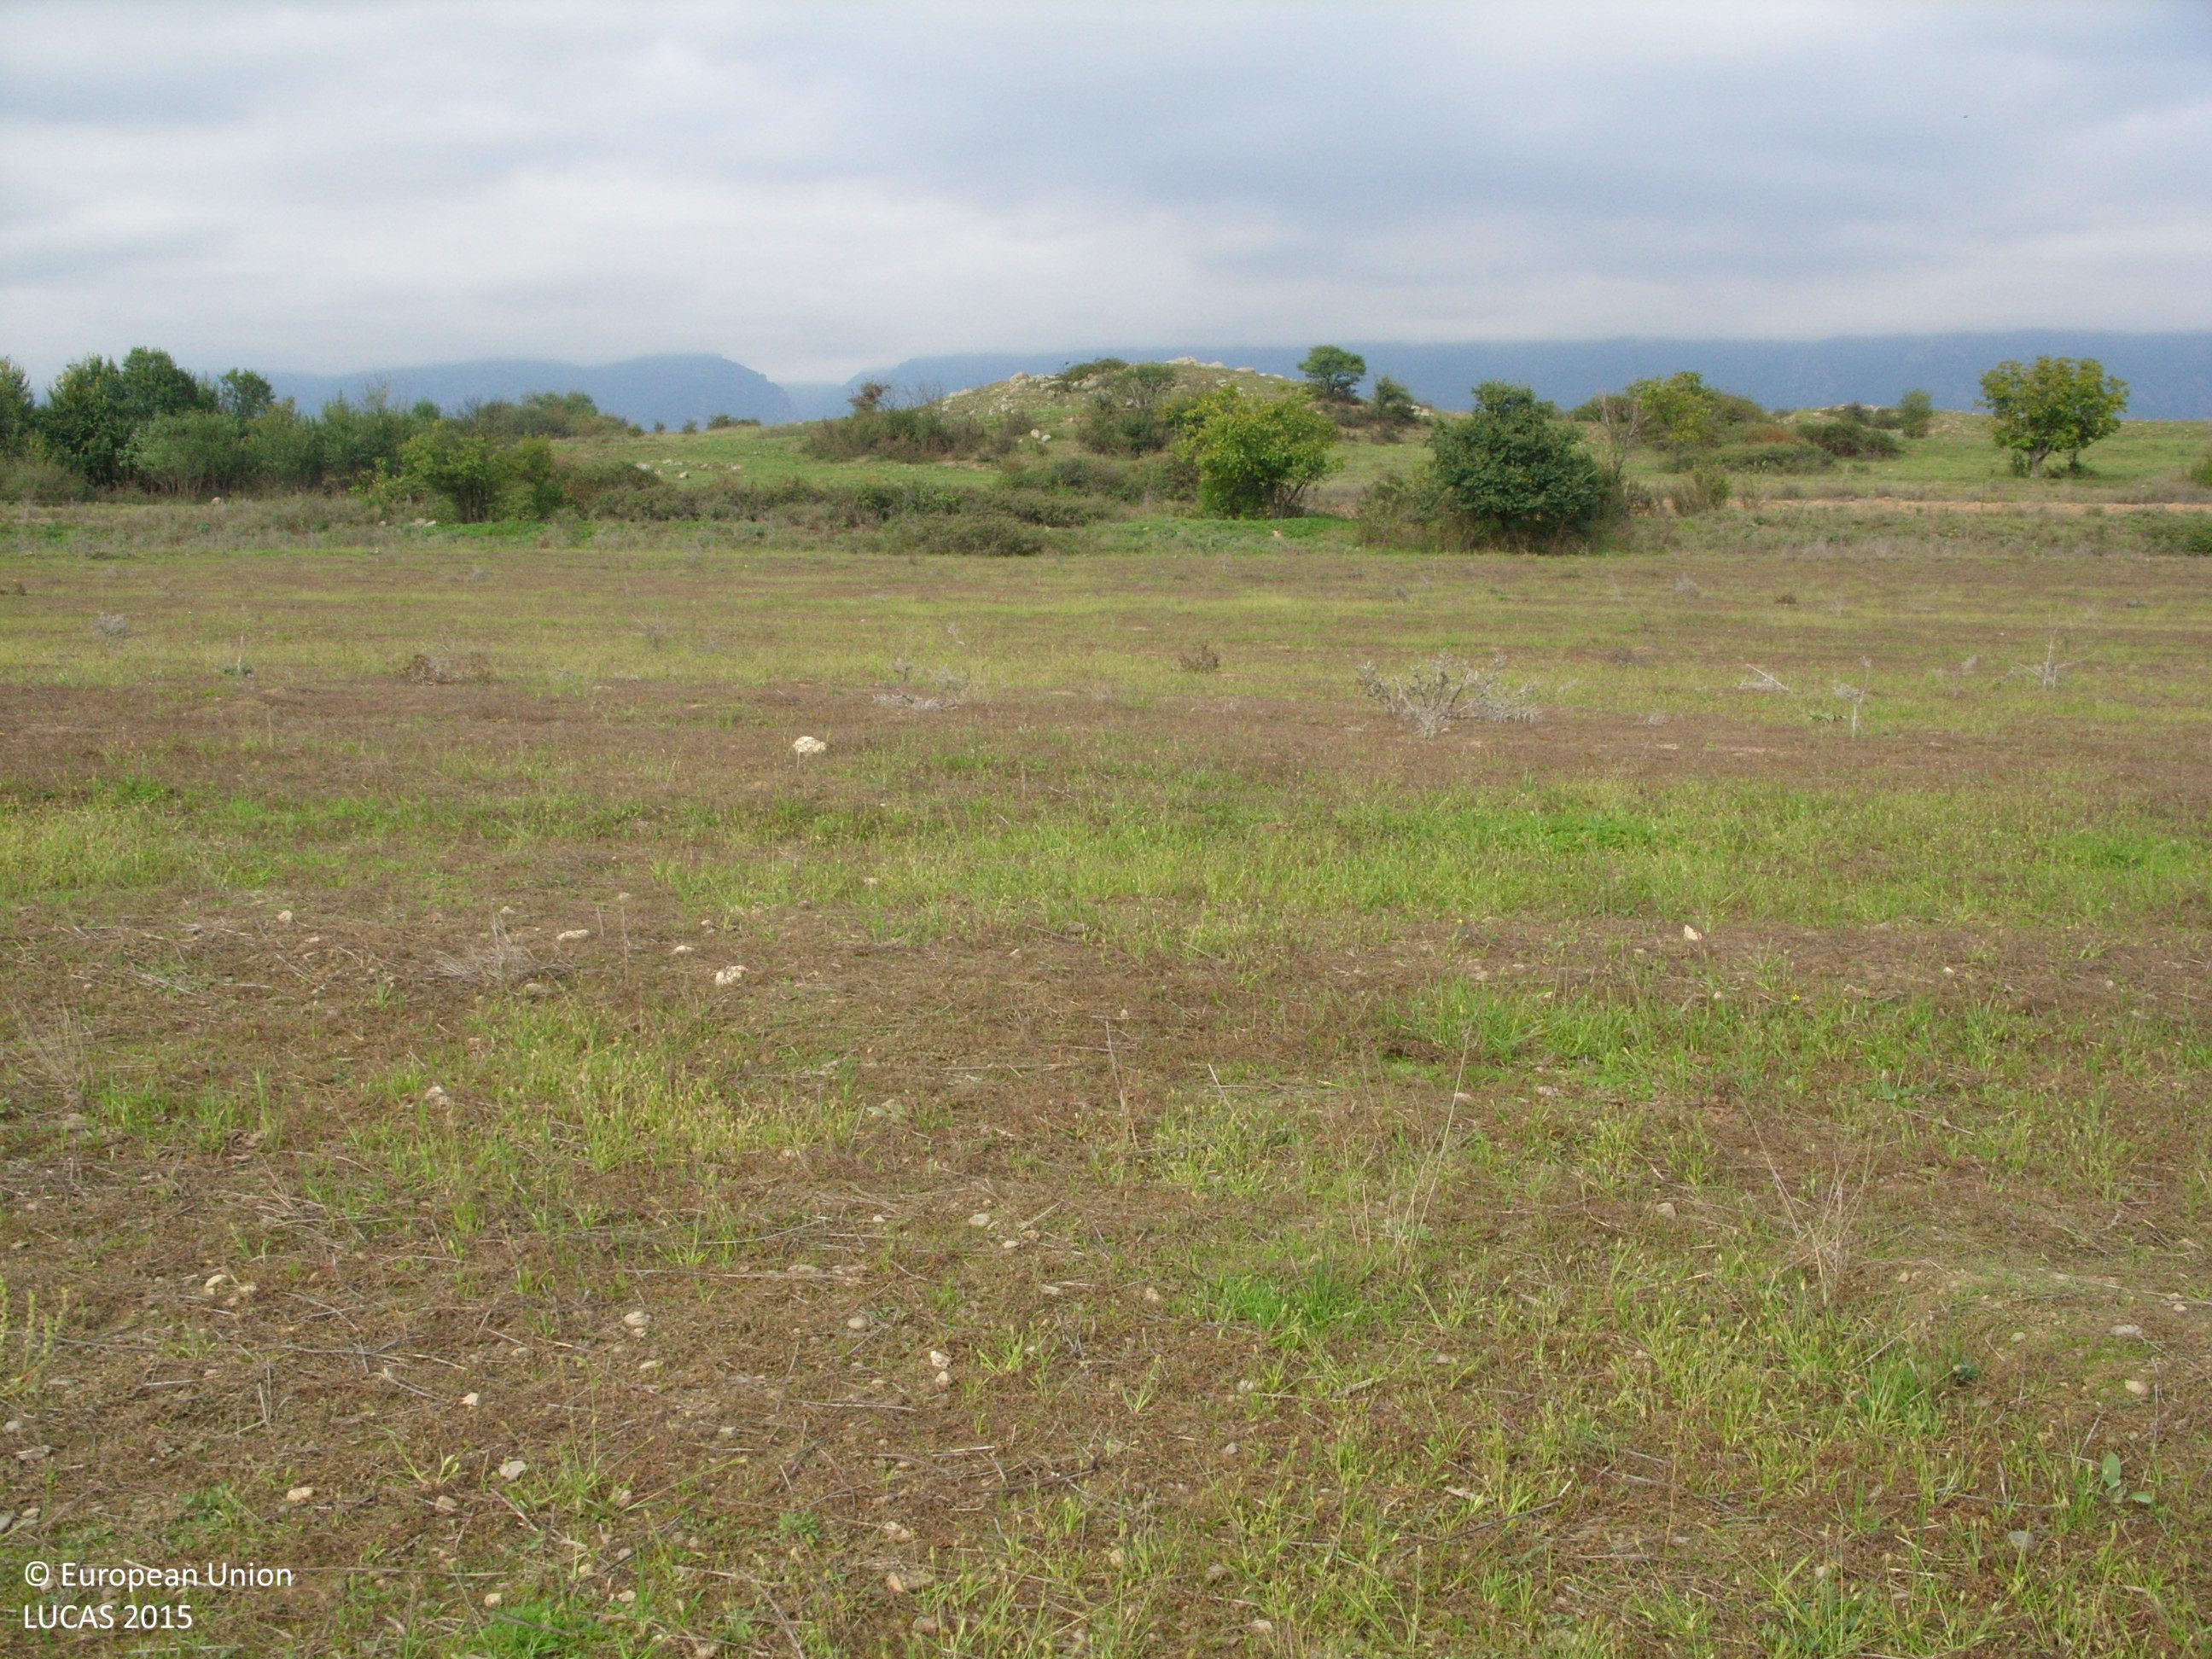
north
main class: Grassland
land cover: Spontaneously vegetated surfaces
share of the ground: > 75 %
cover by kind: herbaceous plants 90 %, unconsolidated bare surface 10 %
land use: Agriculture (excluding fallow land and kitchen gardens)
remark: Harvested field
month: October
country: BG
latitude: 42.5842
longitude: 24.8136
